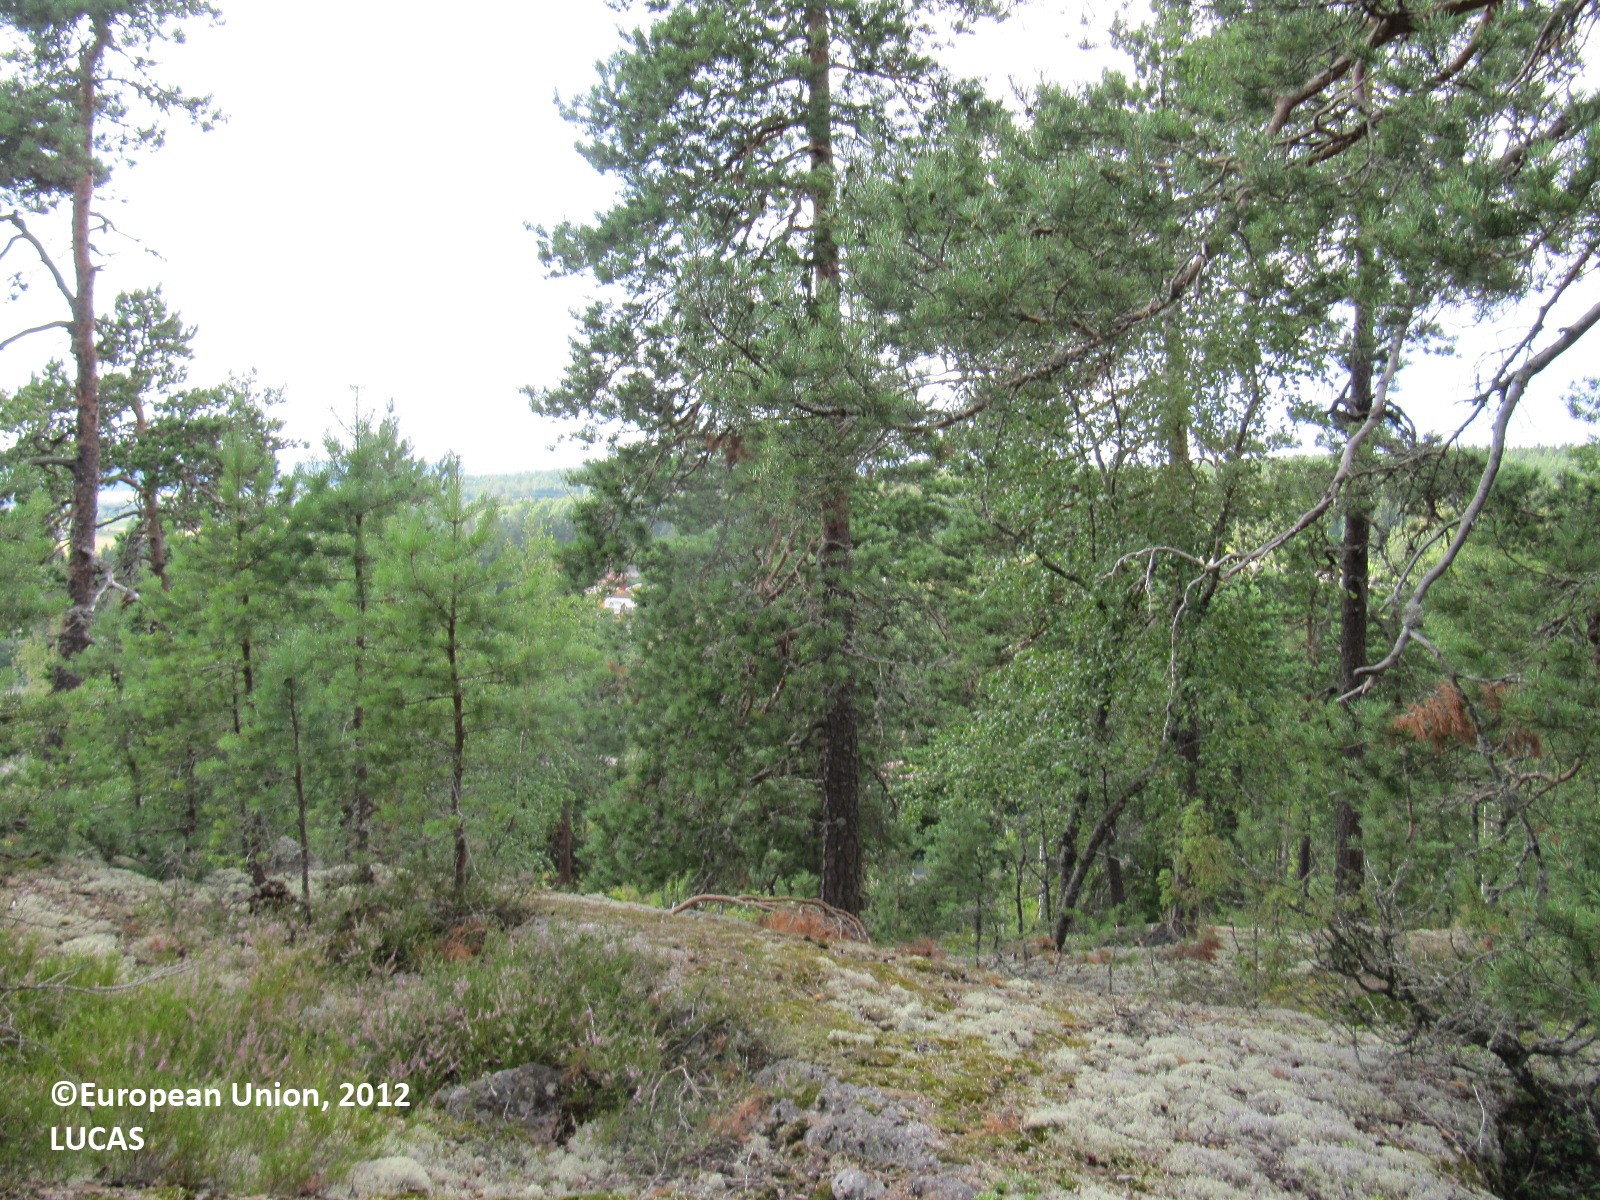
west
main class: Woodland
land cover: Pine dominated mixed woodland
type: boreal forest
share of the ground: 50 - 75 %
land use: Forestry
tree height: > 5 m
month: August
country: FI
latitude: 60.3802
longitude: 23.1964
